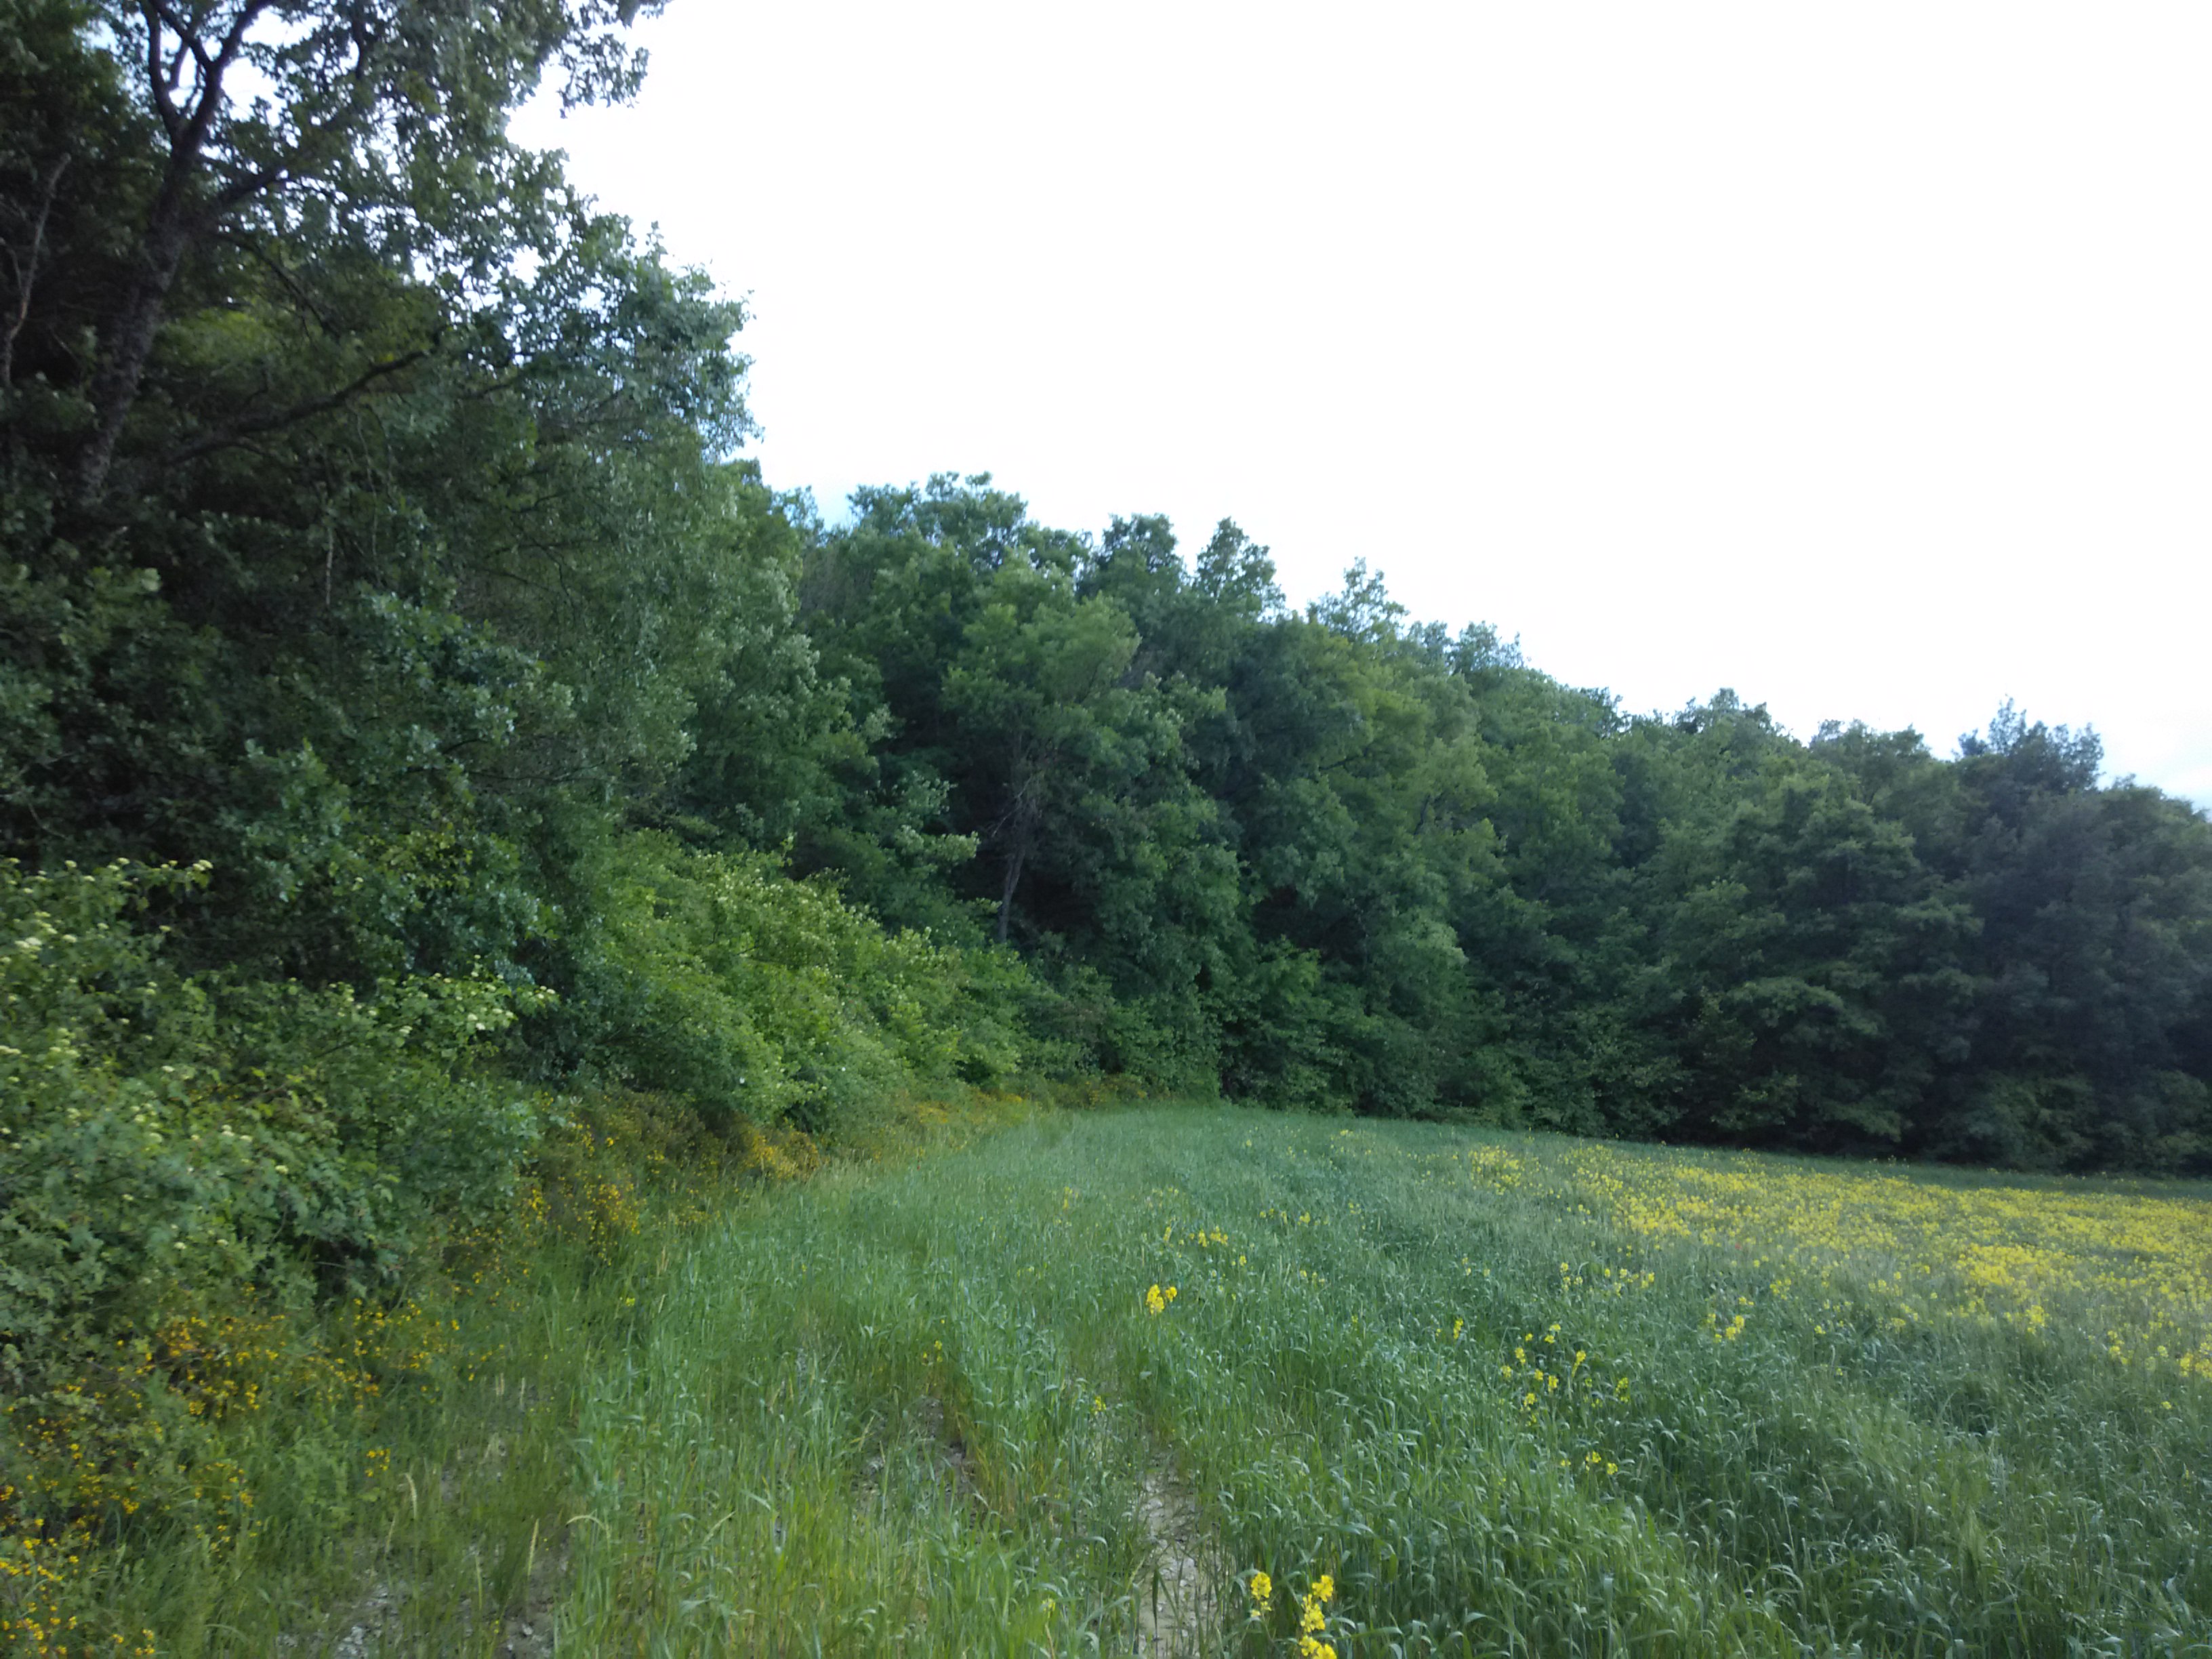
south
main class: Woodland
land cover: Broadleaved woodland
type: beech forest
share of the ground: 50 - 75 %
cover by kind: broadleaved forest trees 55 %, shrubs 30 %, herbaceous plants 15 %
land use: Forestry
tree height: > 5 m
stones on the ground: < 10 %
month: May
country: ES
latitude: 42.8445
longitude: -2.3443
